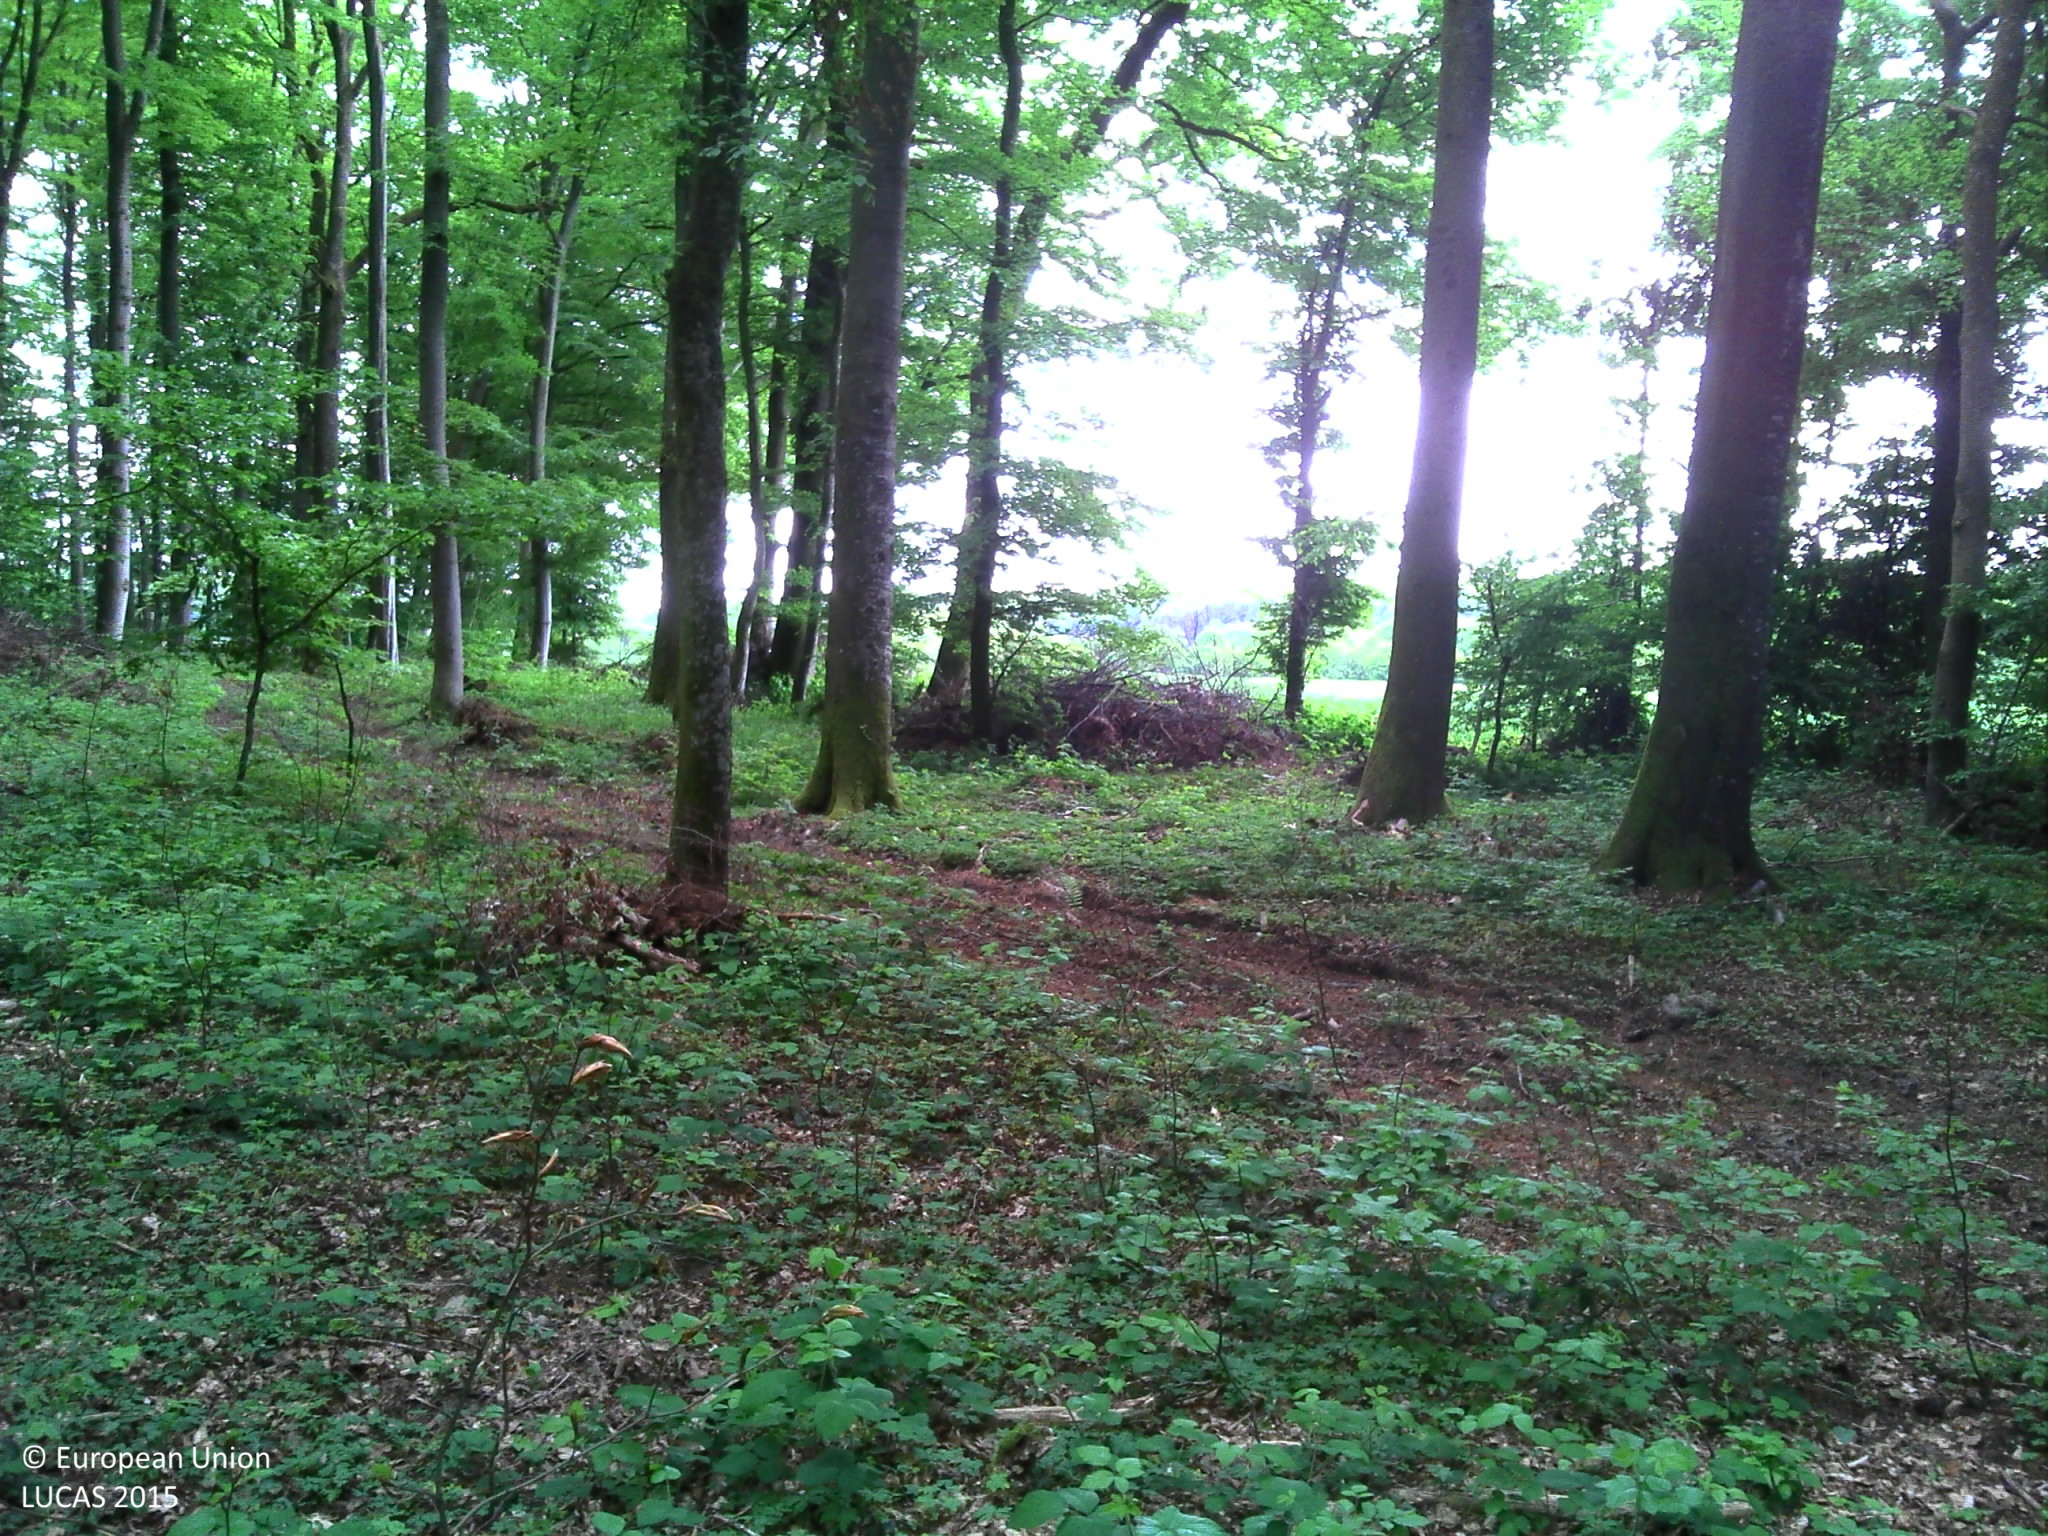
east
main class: Woodland
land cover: Broadleaved woodland
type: beech forest
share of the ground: > 75 %
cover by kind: broadleaved forest trees 85 %, herbaceous plants 10 %, lichens and mosses 5 %
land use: Forestry
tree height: > 5 m
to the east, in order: Broadleaved woodland; Tracks; Broadleaved woodland; Shruby margins; Common wheat; Grass margins; Paved roads, cycling and walking lanes; Grass margins; Oats
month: May
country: LU
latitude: 49.7685
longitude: 5.9032
